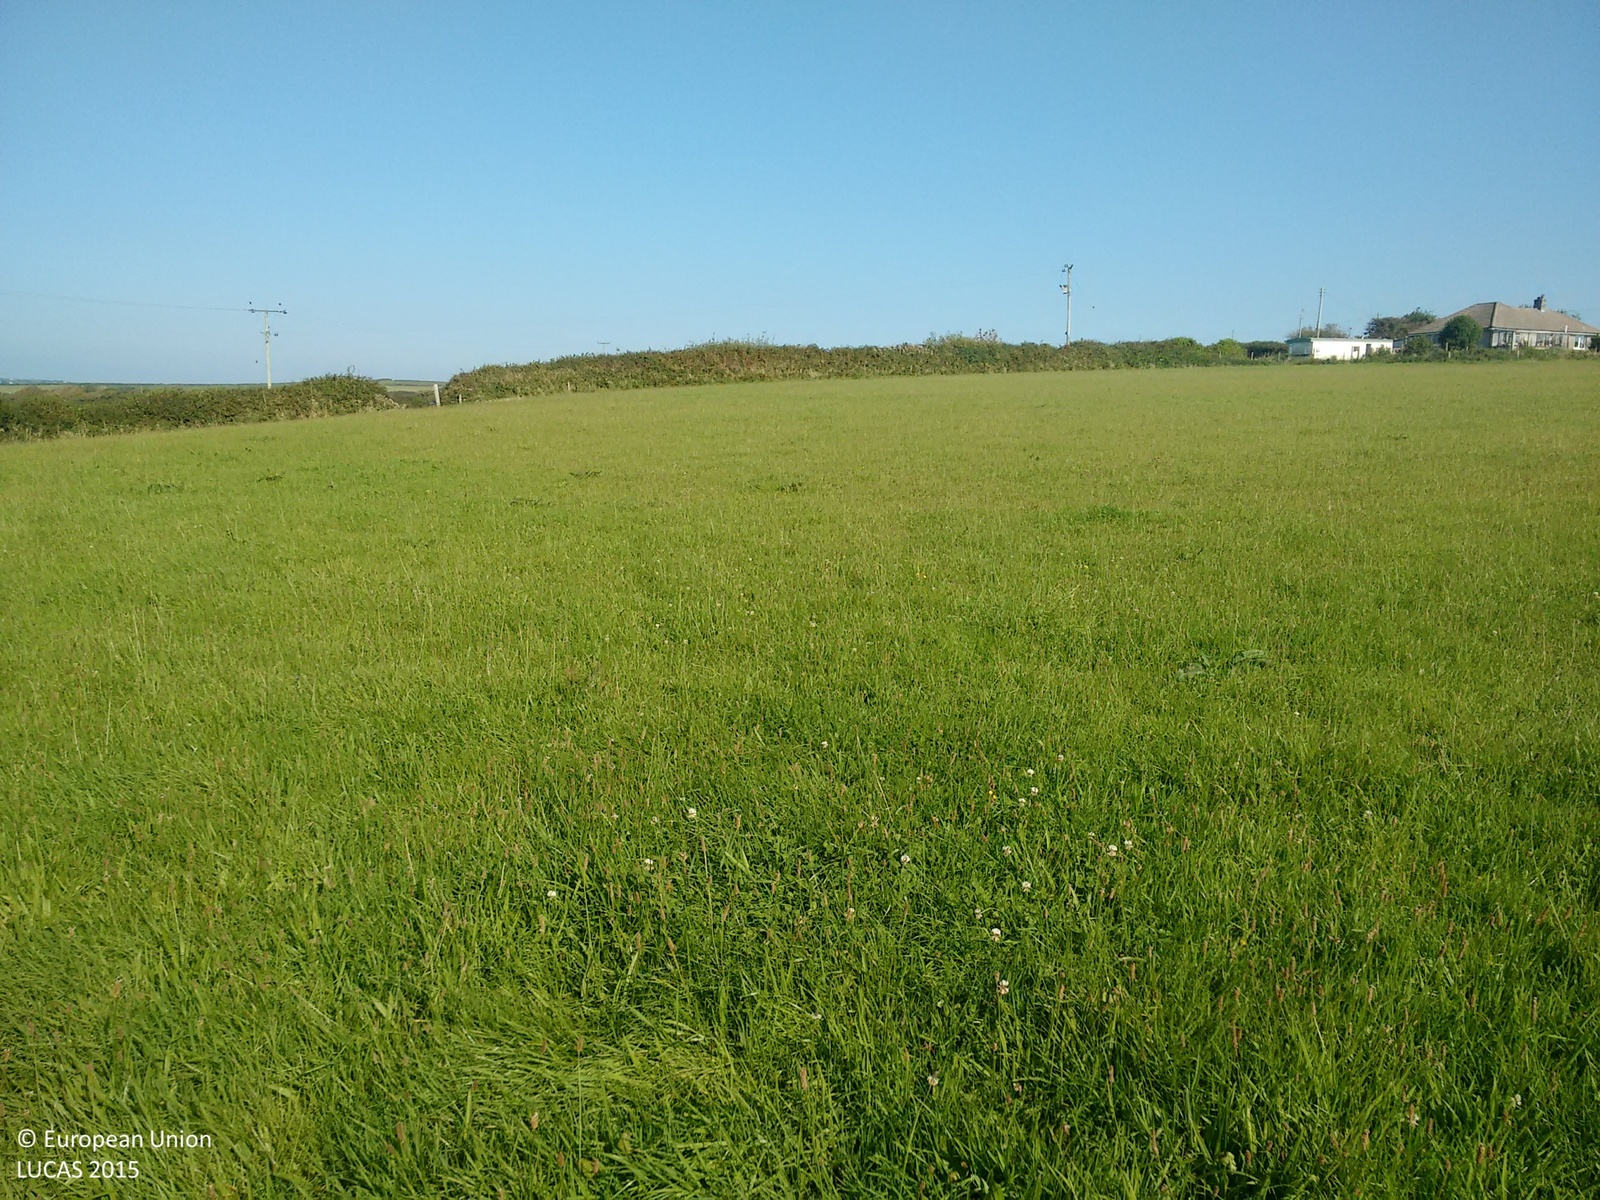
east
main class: Grassland
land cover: Grassland without tree/shrub cover
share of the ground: > 75 %
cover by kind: herbaceous plants 100 %
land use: Agriculture (excluding fallow land and kitchen gardens)
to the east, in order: Grassland without tree/shrub cover; Fences; Managed hedges; Artificial constructions; Grassland without tree/shrub cover; Electric lines; Grassland without tree/shrub cover
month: September
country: GB
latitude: 50.9088
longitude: -4.5410
